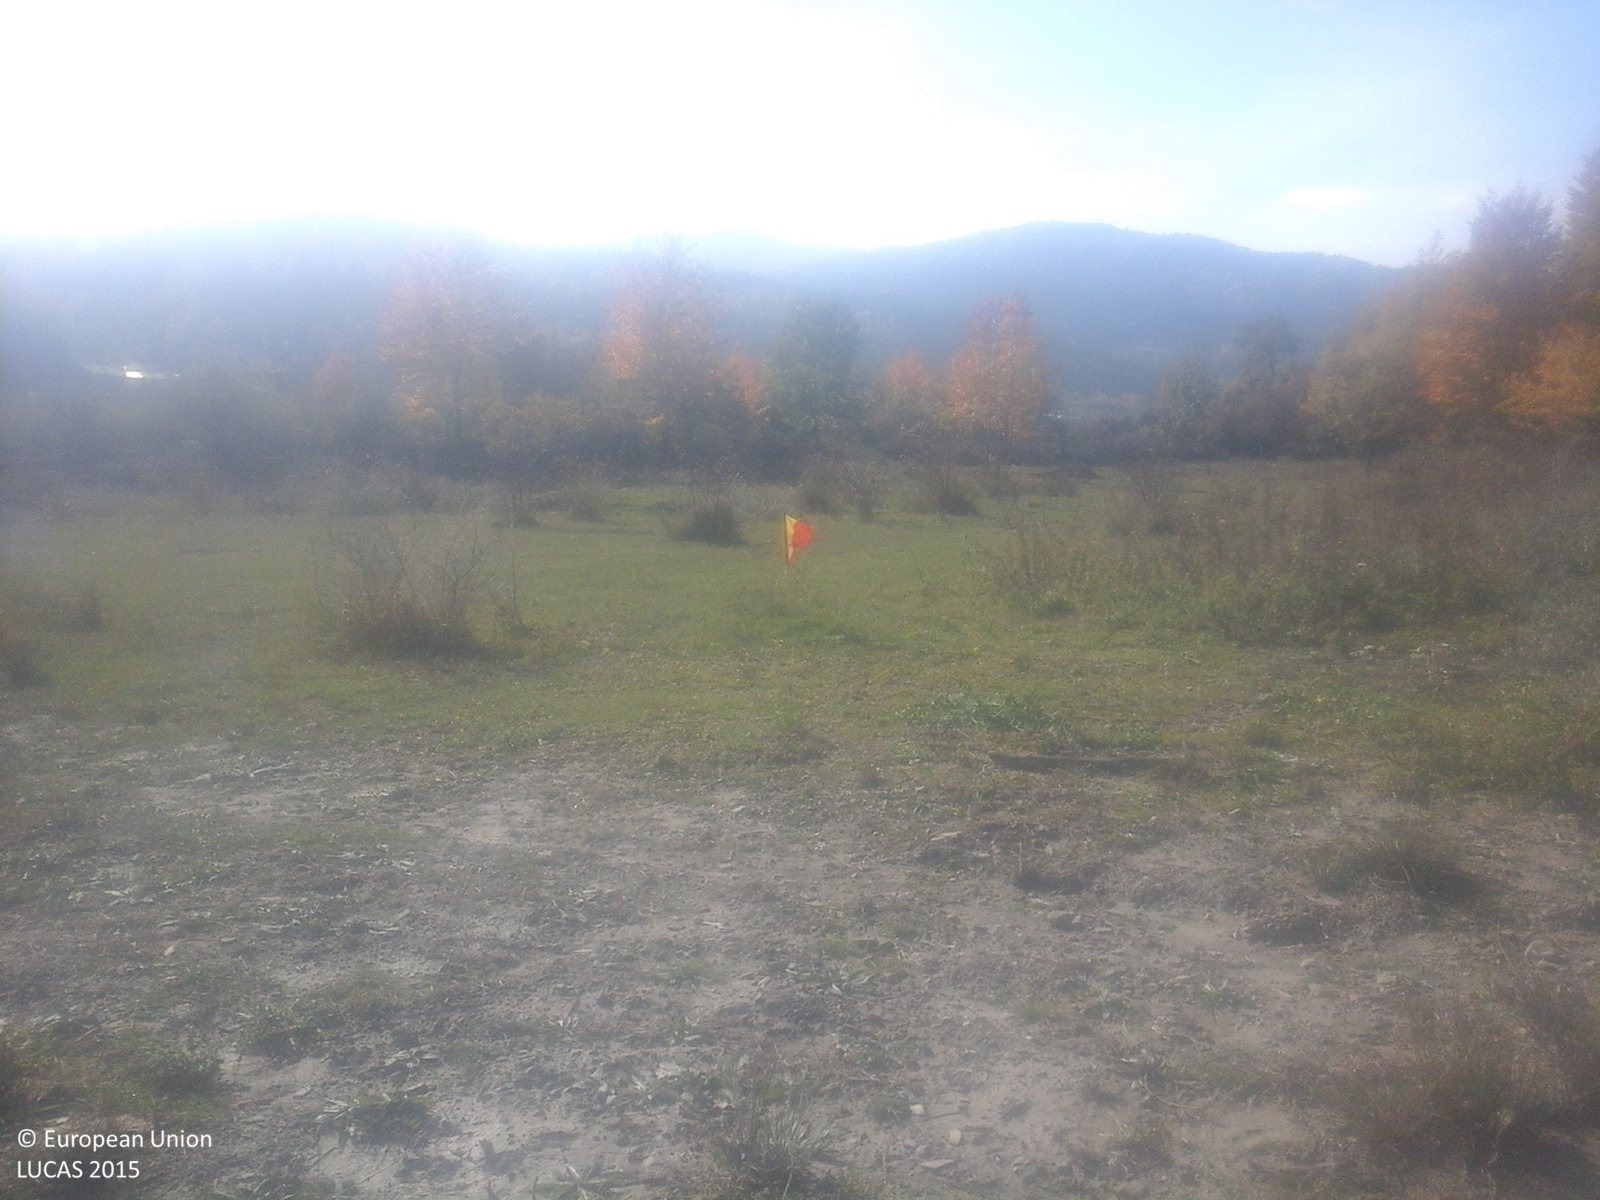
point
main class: Grassland
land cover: Grassland with sparse tree/shrub cover
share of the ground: > 75 %
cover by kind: herbaceous plants 85 %, shrubs 10 %, broadleaved forest trees 5 %
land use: Agriculture (excluding fallow land and kitchen gardens)
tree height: < 5 m
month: October
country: RO
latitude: 45.7080
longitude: 26.6897
